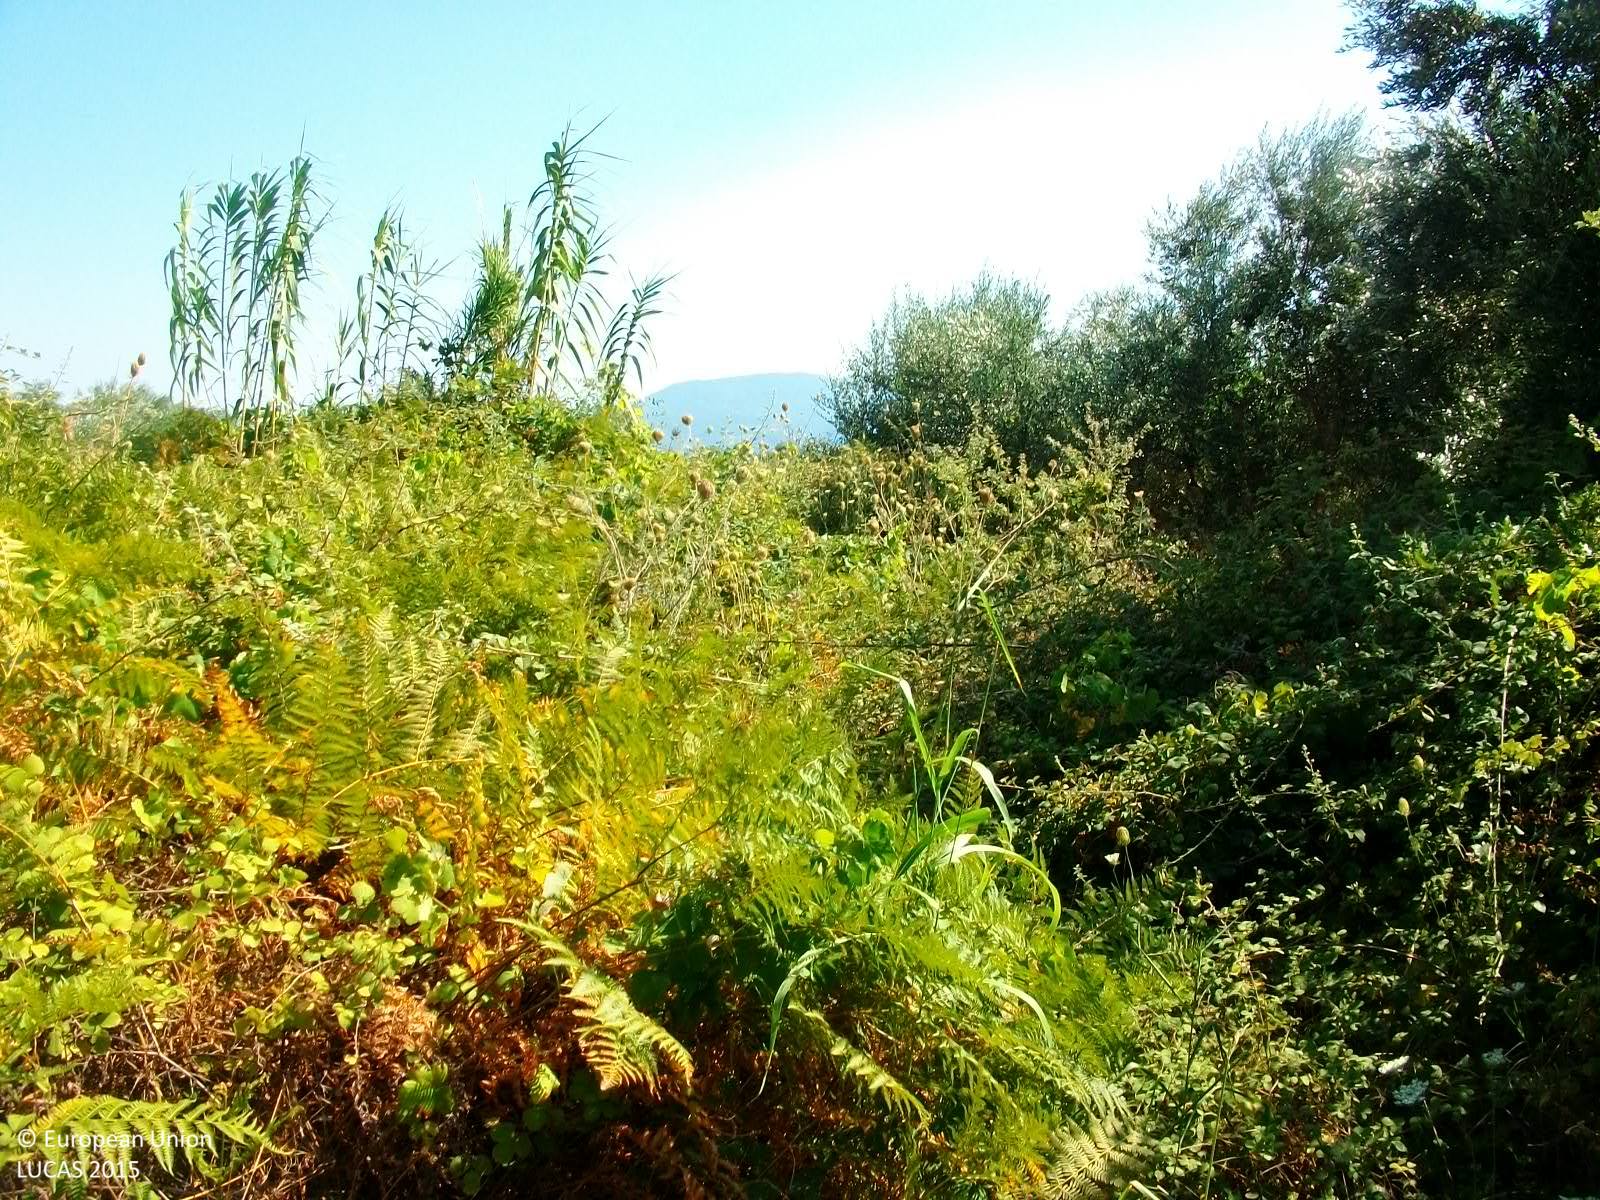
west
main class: Shrubland
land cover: Shrubland without tree cover
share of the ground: > 75 %
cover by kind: shrubs 100 %
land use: Abandoned areas
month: July
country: GR
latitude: 37.0365
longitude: 21.8805
